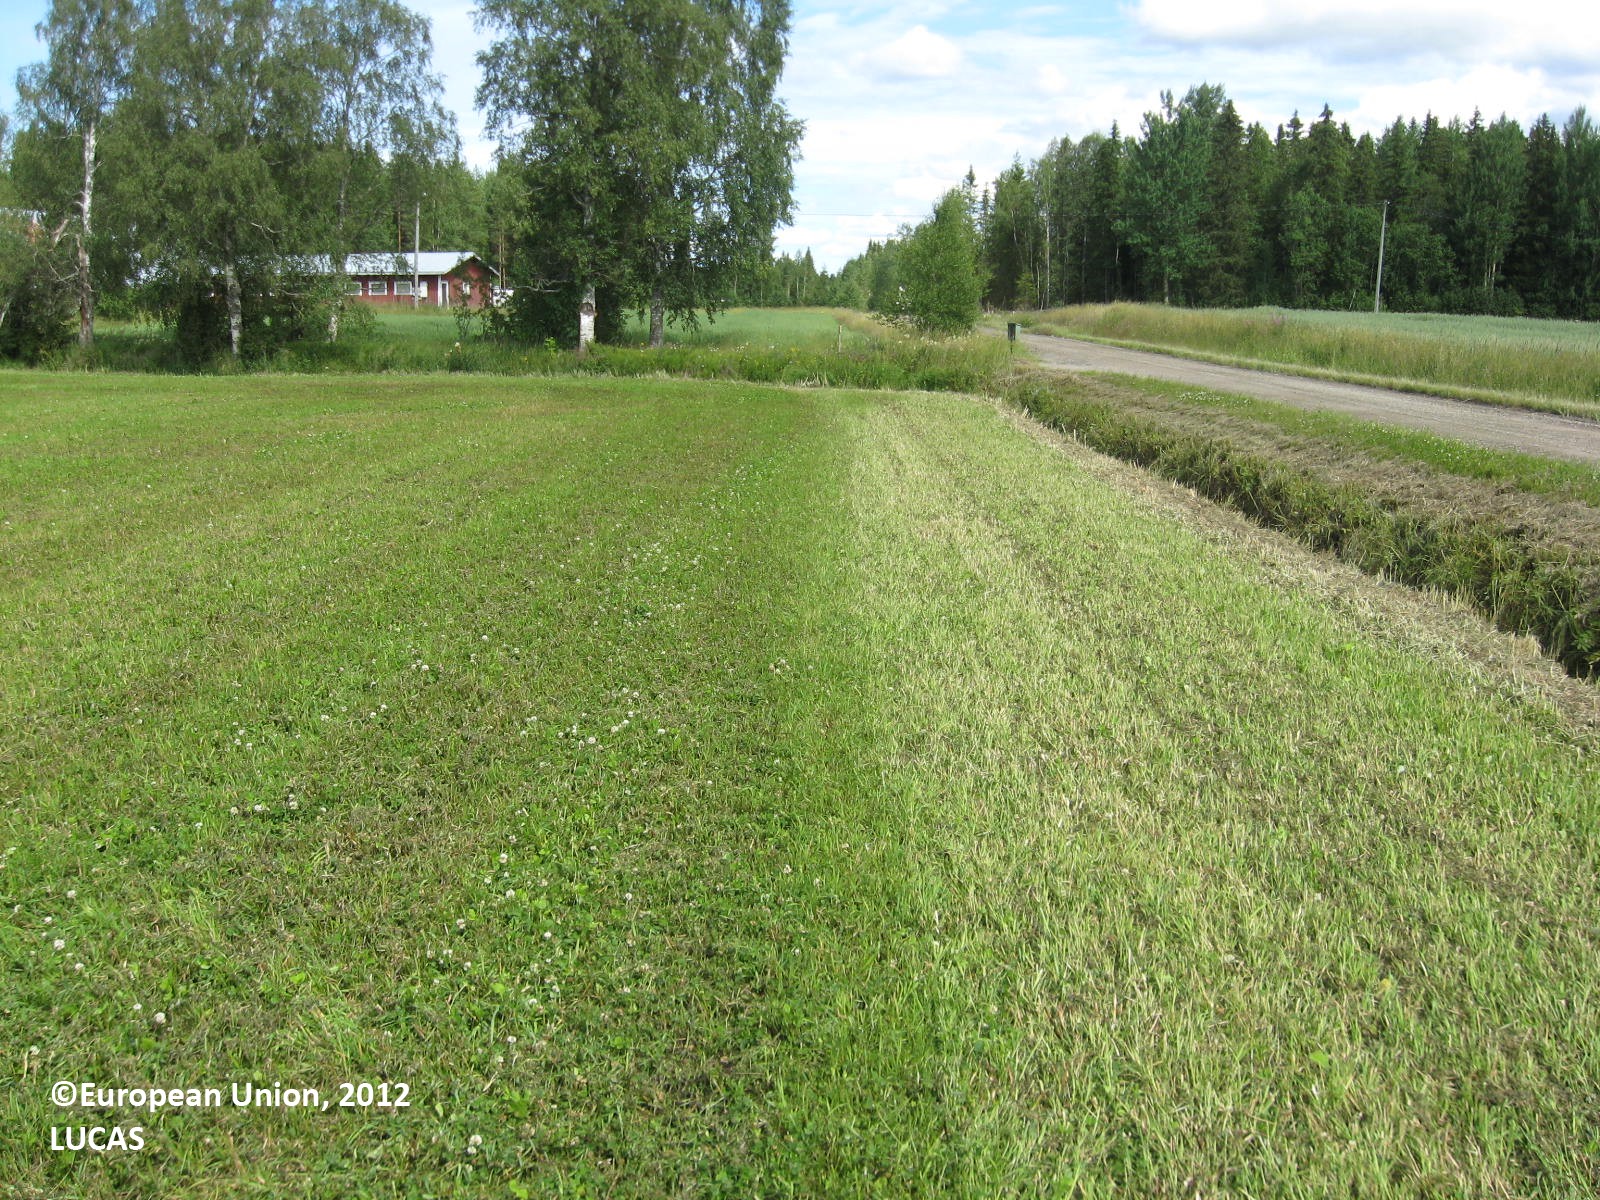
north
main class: Cropland
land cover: Clovers
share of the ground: > 75 %
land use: Agriculture (excluding fallow land and kitchen gardens)
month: July
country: FI
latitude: 62.3292
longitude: 21.5689
